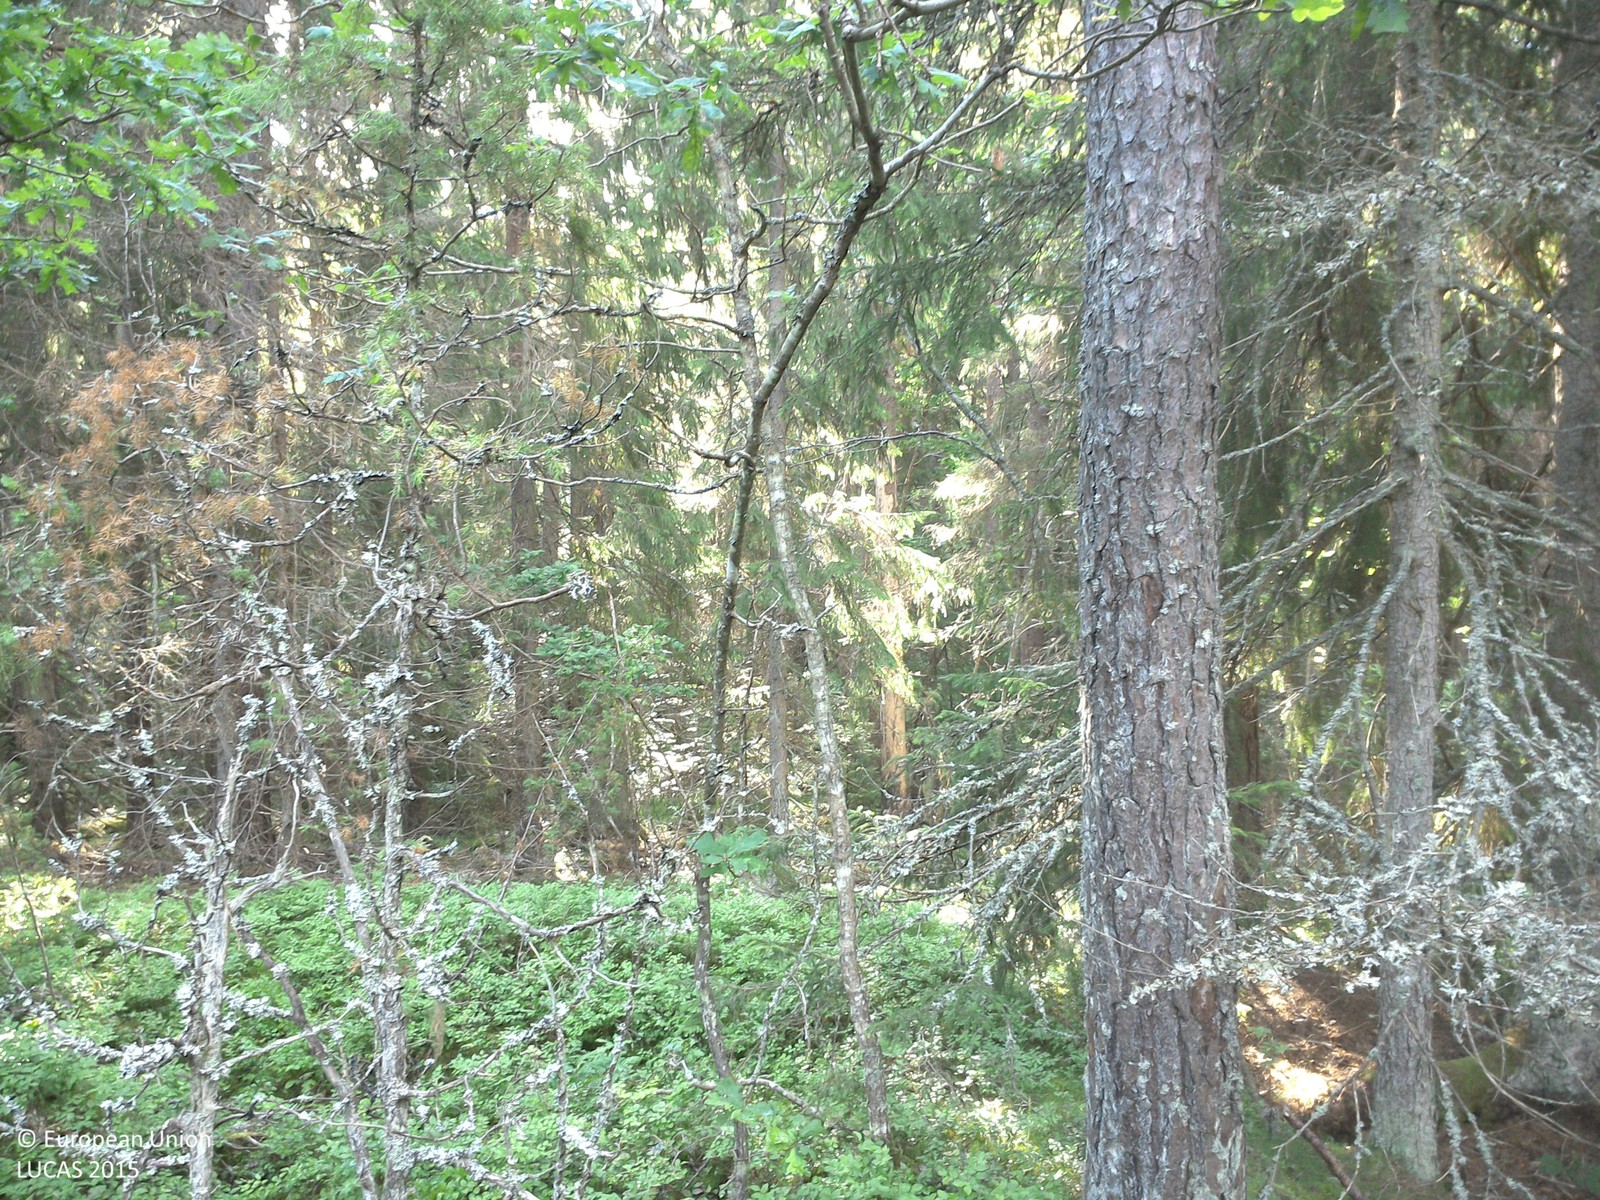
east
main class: Woodland
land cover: Spruce dominated coniferous woodland
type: boreal forest
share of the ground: 50 - 75 %
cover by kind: coniferous forest trees 60 %, herbaceous plants 20 %, lichens and mosses 20 %
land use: Forestry
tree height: > 5 m
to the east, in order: Spruce dominated coniferous woodland; Pine dominated coniferous woodland; Spruce dominated coniferous woodland; Dry stone walls; Spruce dominated coniferous woodland; Pine dominated coniferous woodland; Spruce dominated mixed woodland; Ditches and canals; Paved roads, cycling and walking lanes; Grass margins; Pine dominated mixed woodland
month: July
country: SE
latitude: 57.7175
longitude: 16.1585
